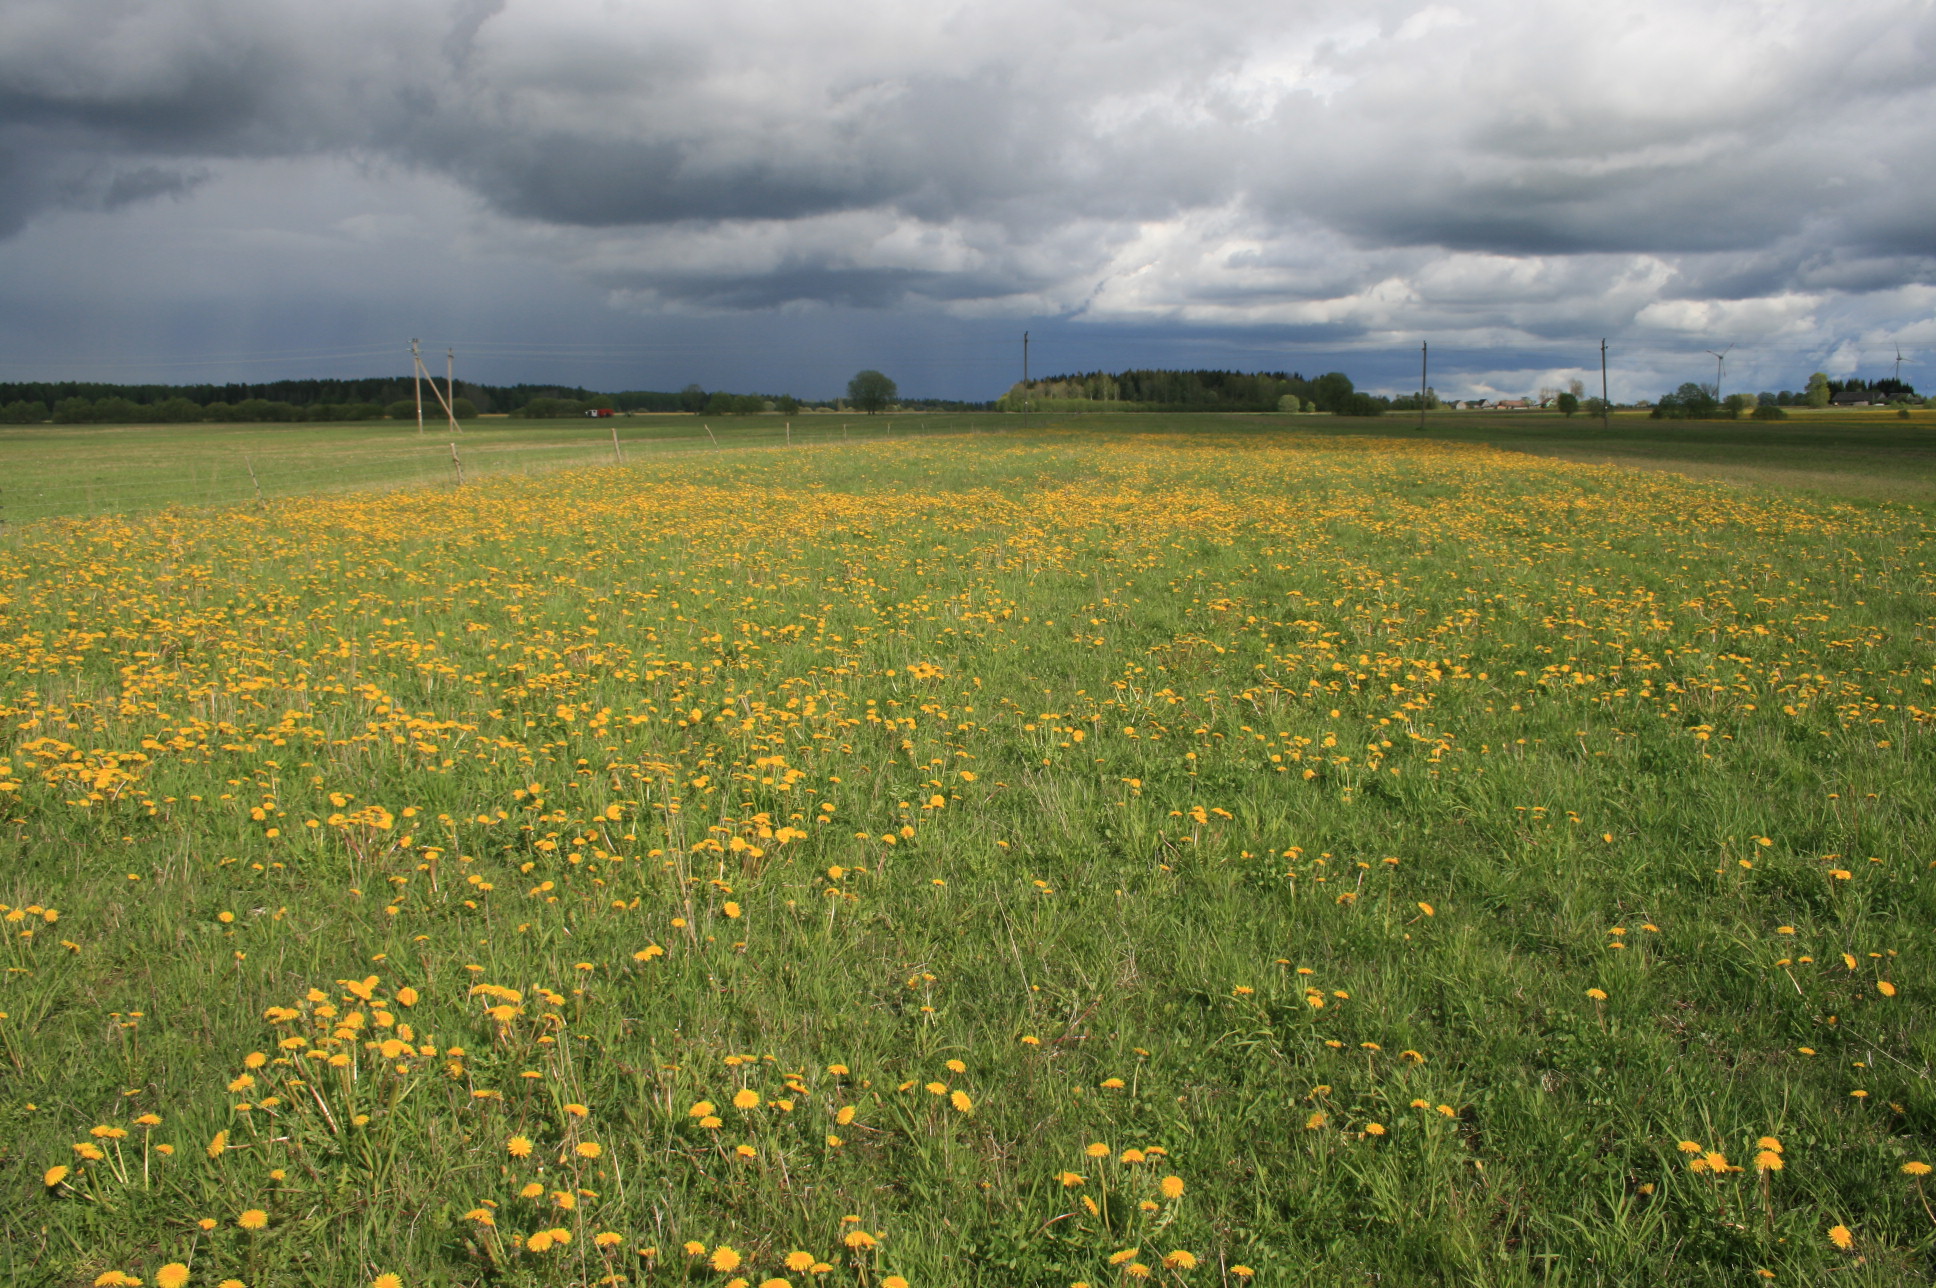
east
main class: Grassland
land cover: Grassland without tree/shrub cover
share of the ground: > 75 %
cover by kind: herbaceous plants 100 %
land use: Agriculture (excluding fallow land and kitchen gardens)
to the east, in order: Grassland without tree/shrub cover; Fences; Grassland without tree/shrub cover; Electric lines; Grassland without tree/shrub cover; Electric lines; Grassland without tree/shrub cover
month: May
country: LT
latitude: 56.1960
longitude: 22.0910
